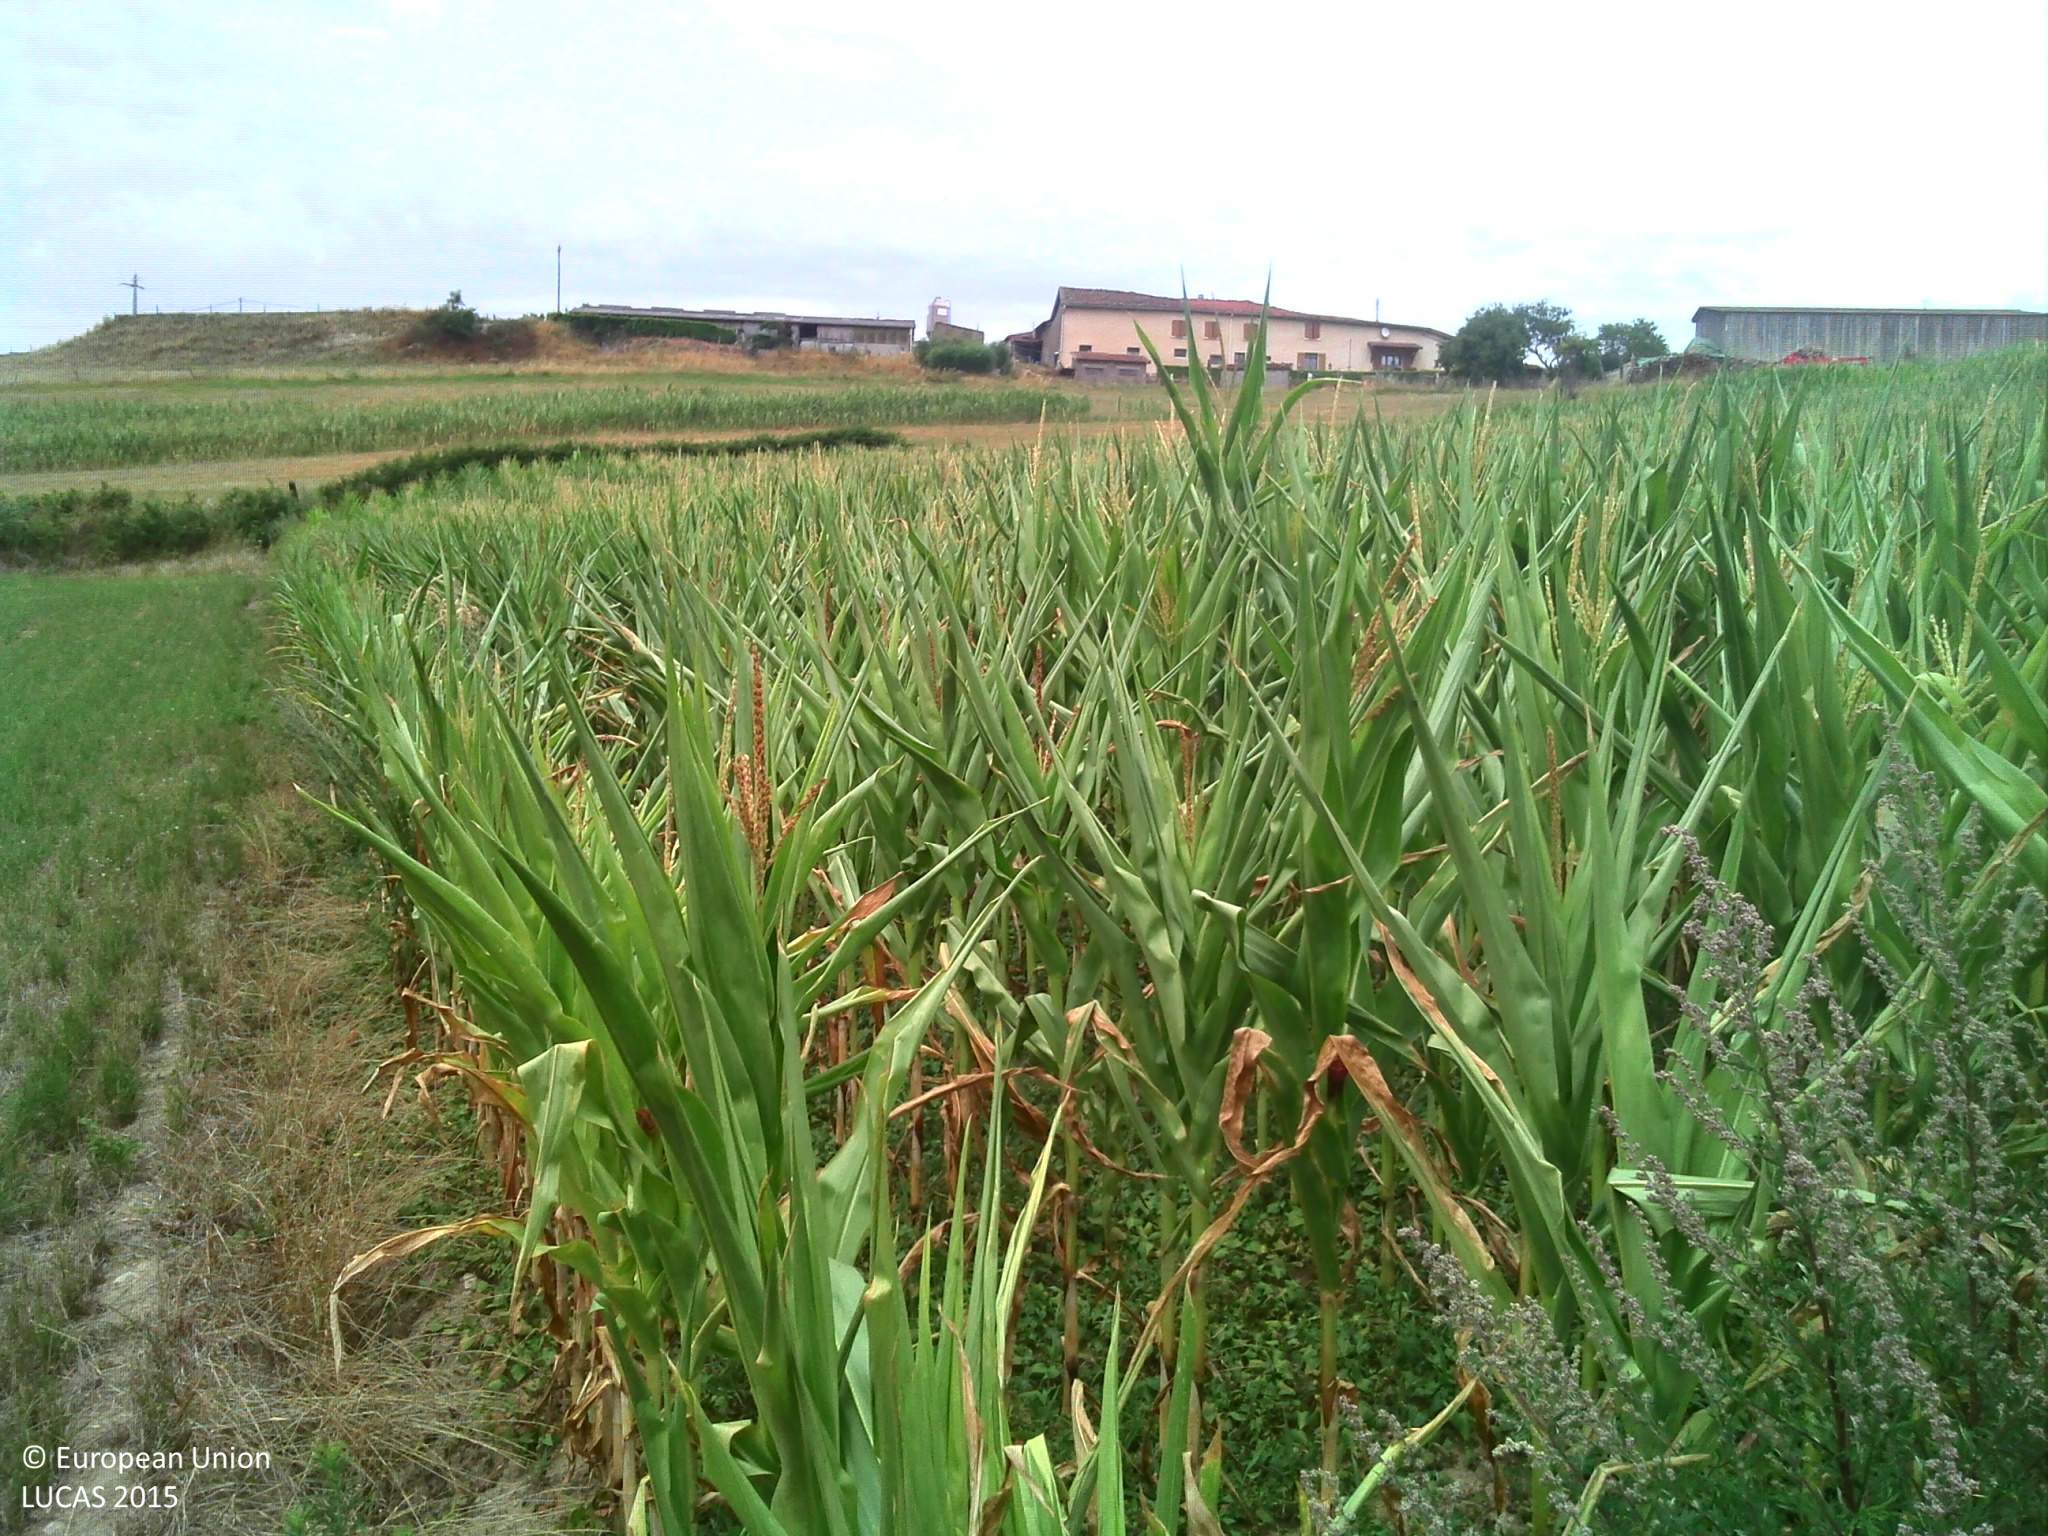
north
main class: Cropland
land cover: Maize
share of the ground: > 75 %
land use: Agriculture (excluding fallow land and kitchen gardens)
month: July
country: FR
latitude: 45.5947
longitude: 4.4785
